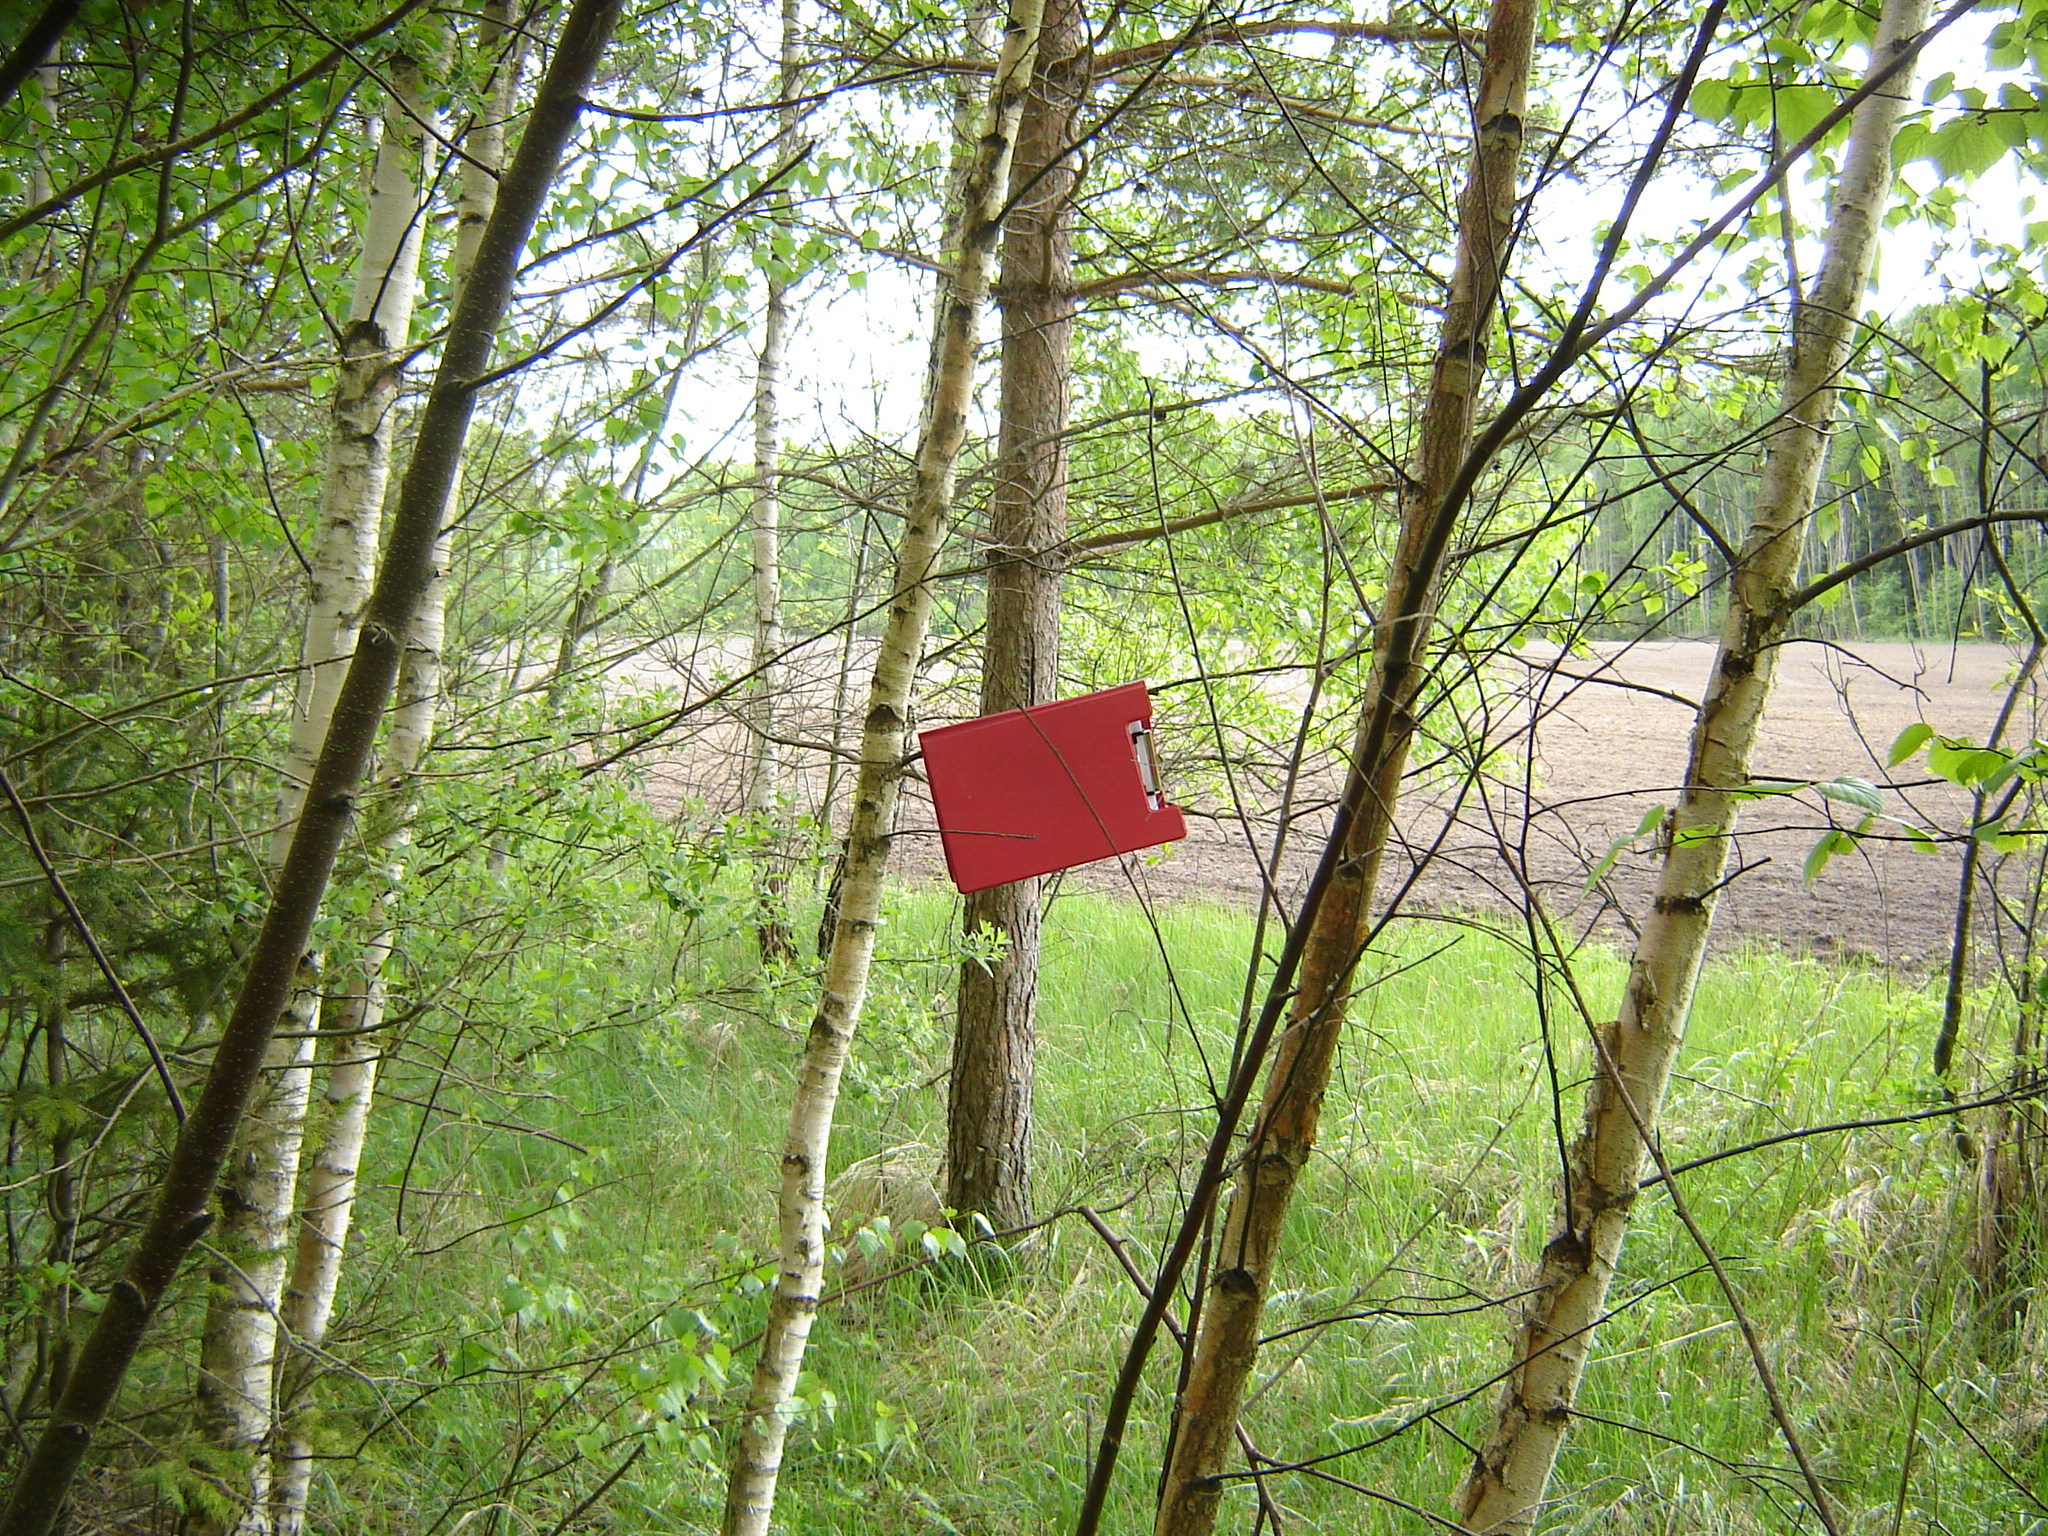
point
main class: Woodland
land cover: Broadleaved woodland
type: non-riverine alder, birch or aspen forest
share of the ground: > 75 %
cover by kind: broadleaved forest trees 80 %, herbaceous plants 10 %, coniferous forest trees 5 %, shrubs 5 %
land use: Forestry
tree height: > 5 m
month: May
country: LT
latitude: 56.1008
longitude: 25.3425
